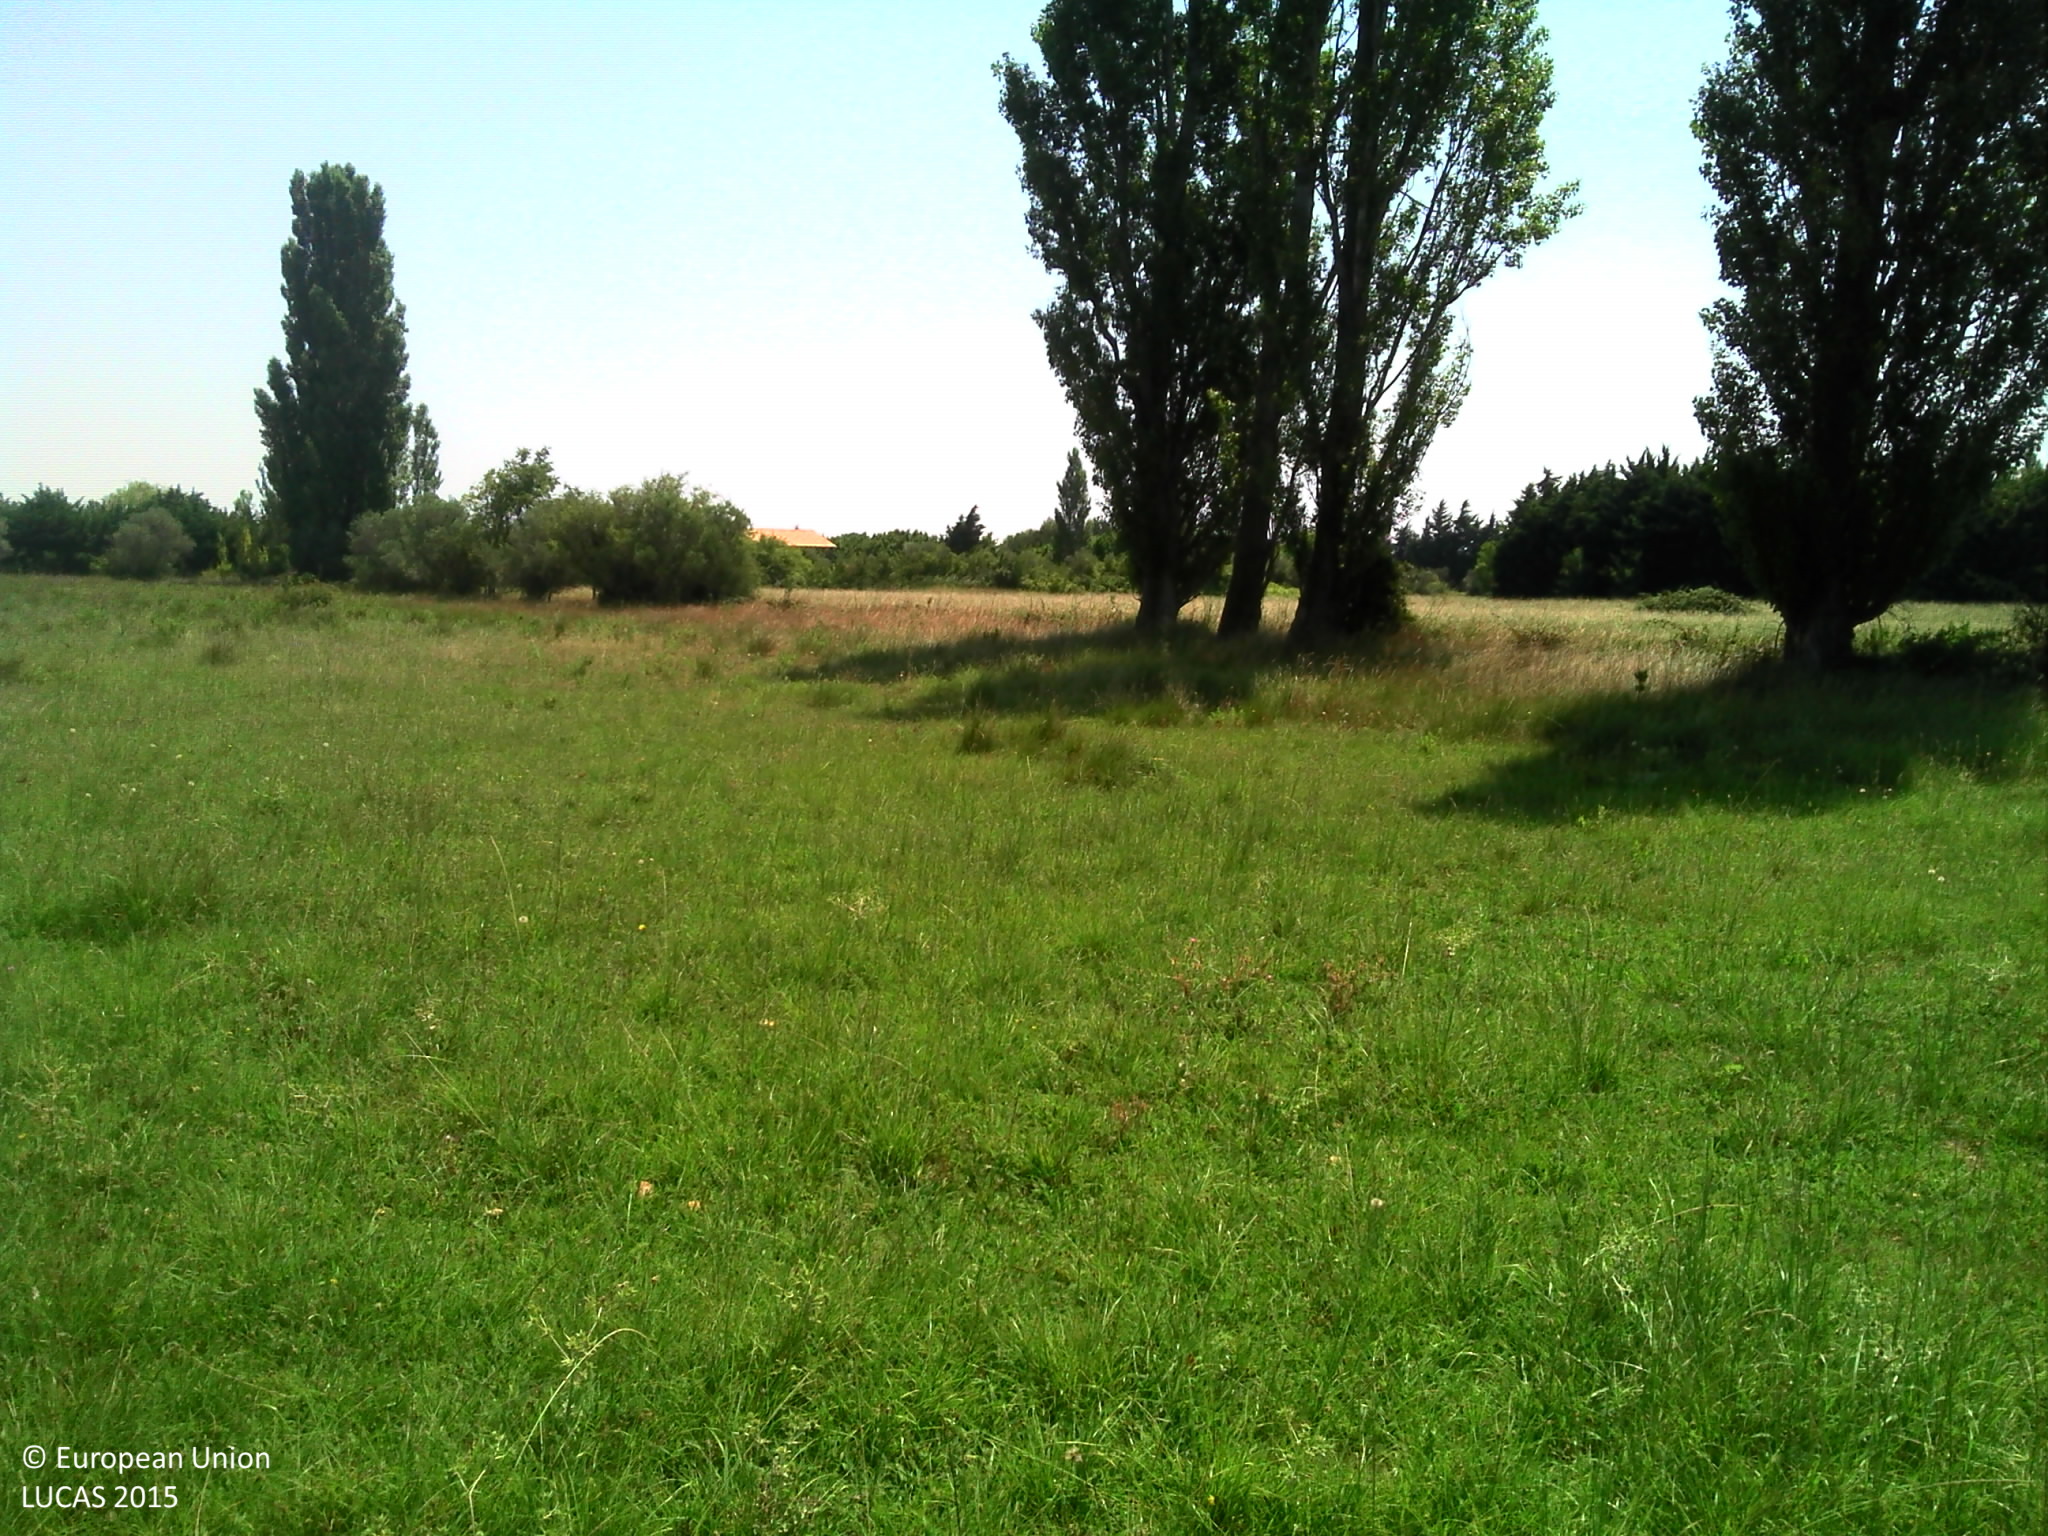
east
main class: Grassland
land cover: Grassland without tree/shrub cover
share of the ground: > 75 %
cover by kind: herbaceous plants 100 %
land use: Agriculture (excluding fallow land and kitchen gardens)
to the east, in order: Grassland without tree/shrub cover; Lines of trees; Abandoned hedges; Grassland with sparse tree/shrub cover; Abandoned hedges; Spontaneously vegetated surfaces; Abandoned hedges; Artificial constructions in urban areas; Conifer hedges; Grassland without tree/shrub cover
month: July
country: FR
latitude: 43.6723
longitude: 4.6886
